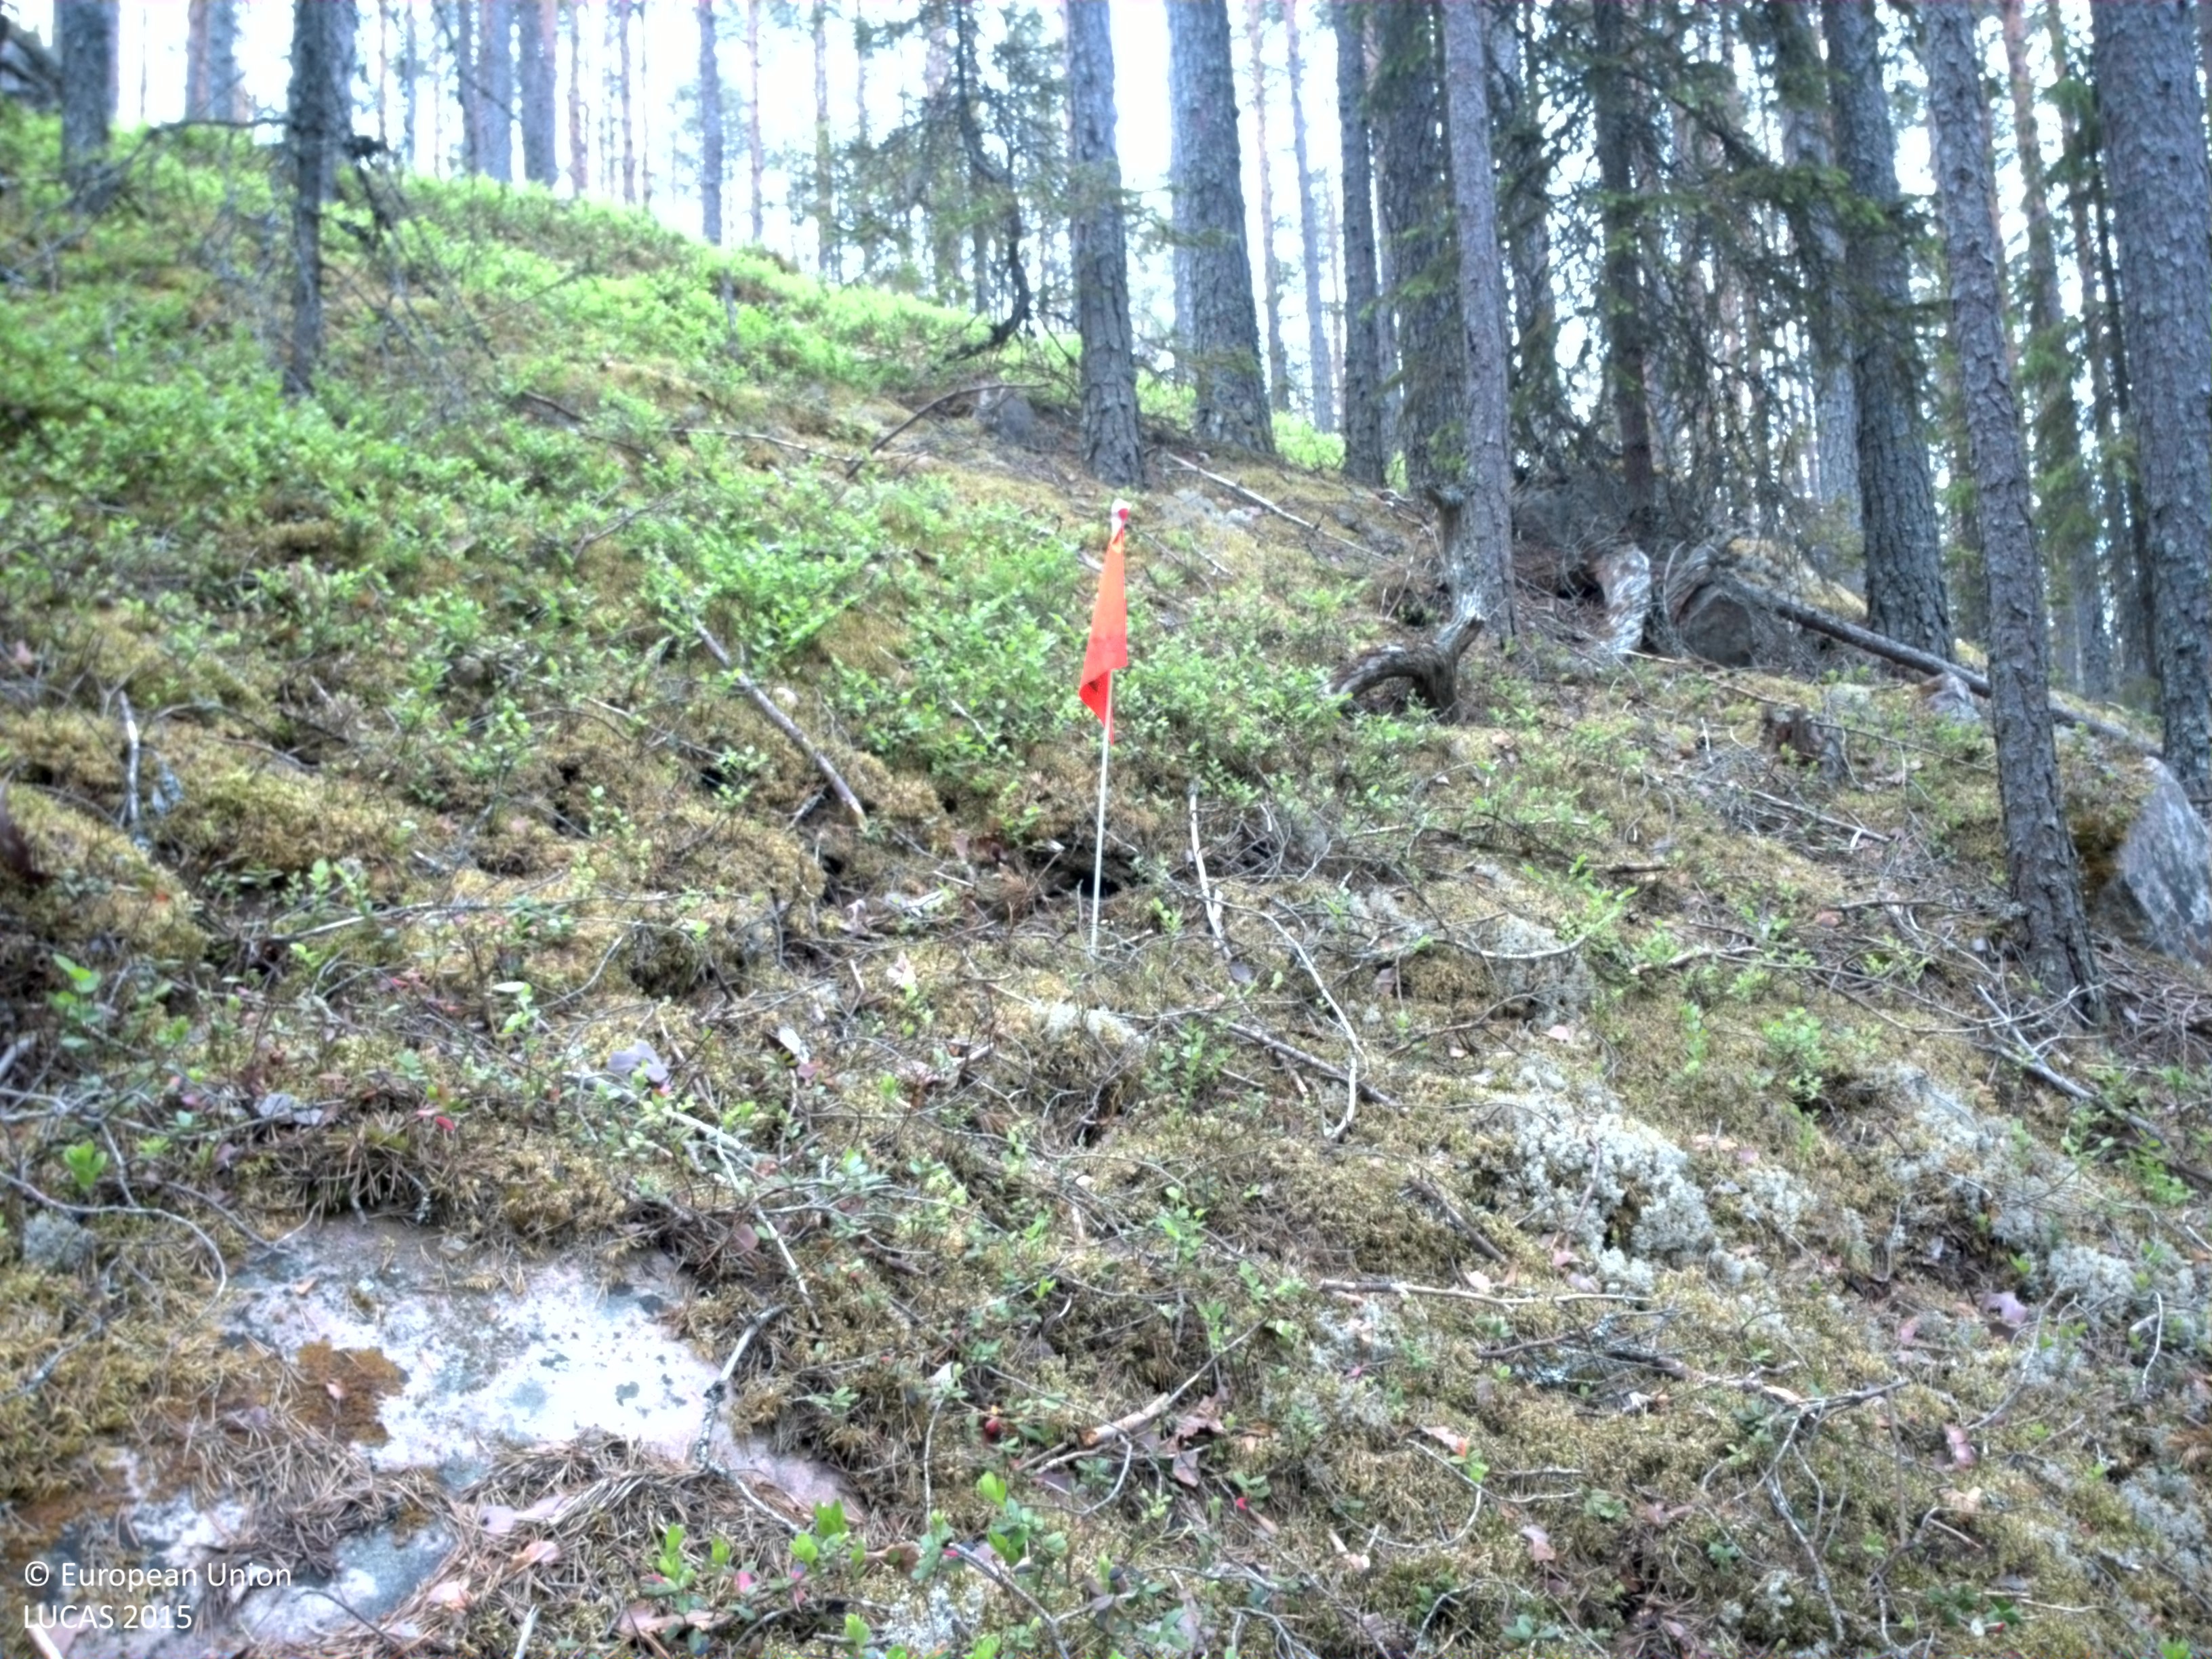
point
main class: Woodland
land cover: Pine dominated coniferous woodland
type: boreal forest
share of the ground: > 75 %
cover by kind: coniferous forest trees 75 %, herbaceous plants 10 %, lichens and mosses 10 %, broadleaved forest trees 5 %
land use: Forestry
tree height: > 5 m
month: June
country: SE
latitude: 61.1637
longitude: 13.5381
